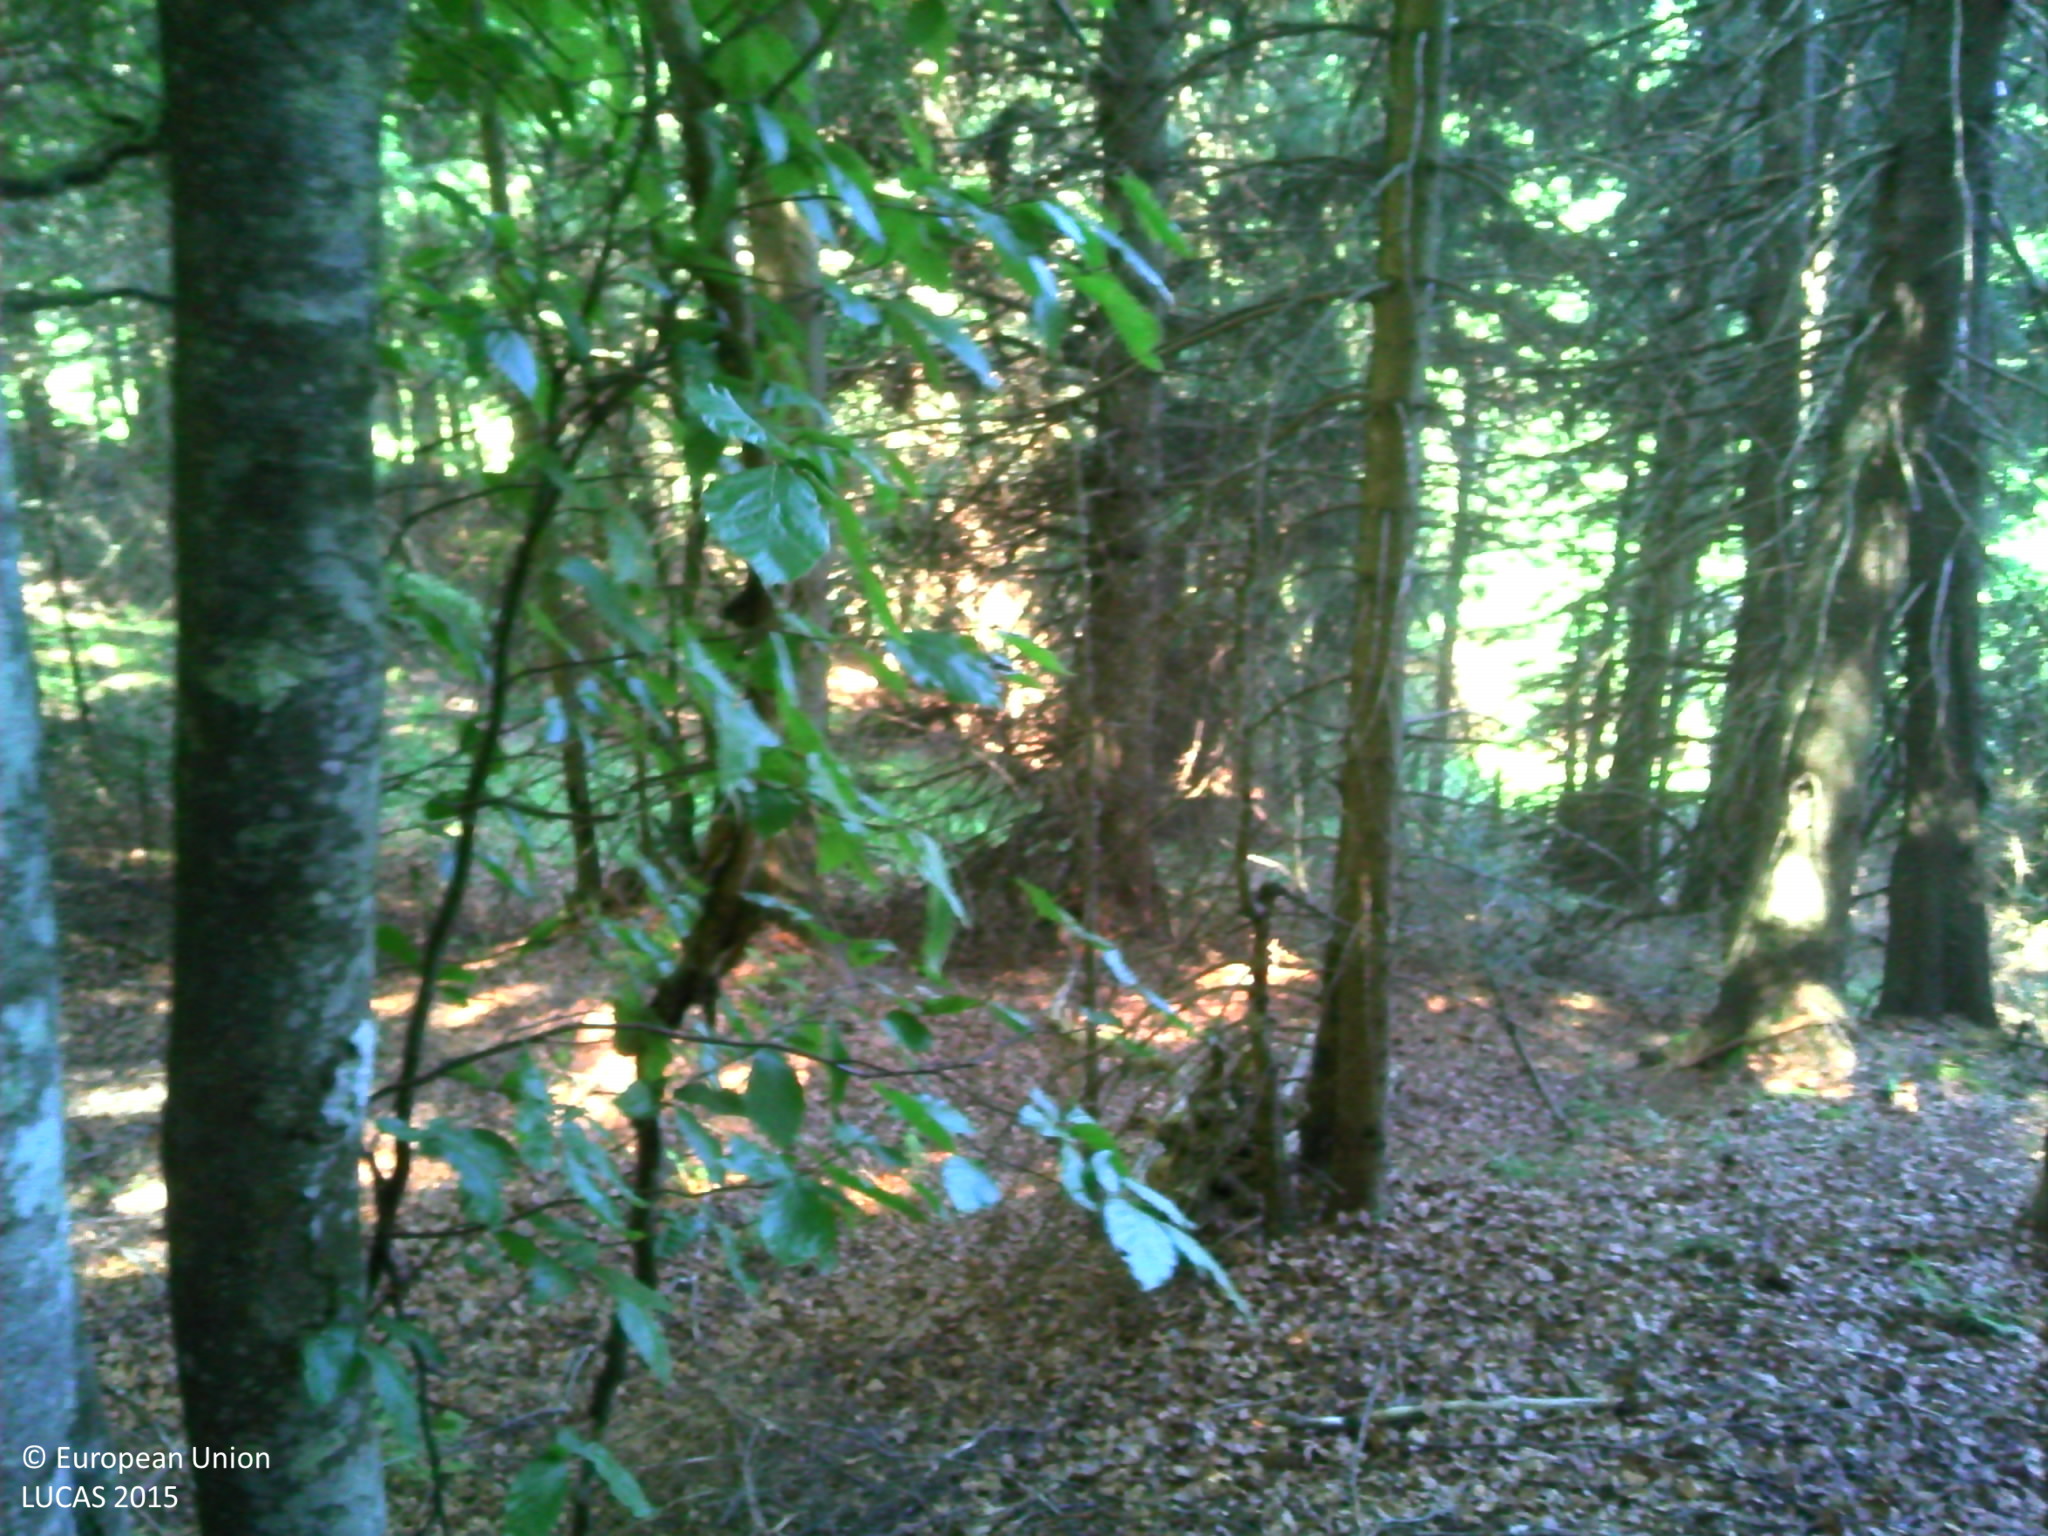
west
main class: Woodland
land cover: Spruce dominated mixed woodland
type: mountainous beech forest
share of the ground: > 75 %
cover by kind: coniferous forest trees 50 %, broadleaved forest trees 30 %, herbaceous plants 15 %, lichens and mosses 5 %
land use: Forestry
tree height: > 5 m
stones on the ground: 10 - 25 %
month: July
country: FR
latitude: 45.7593
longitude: 6.1600
